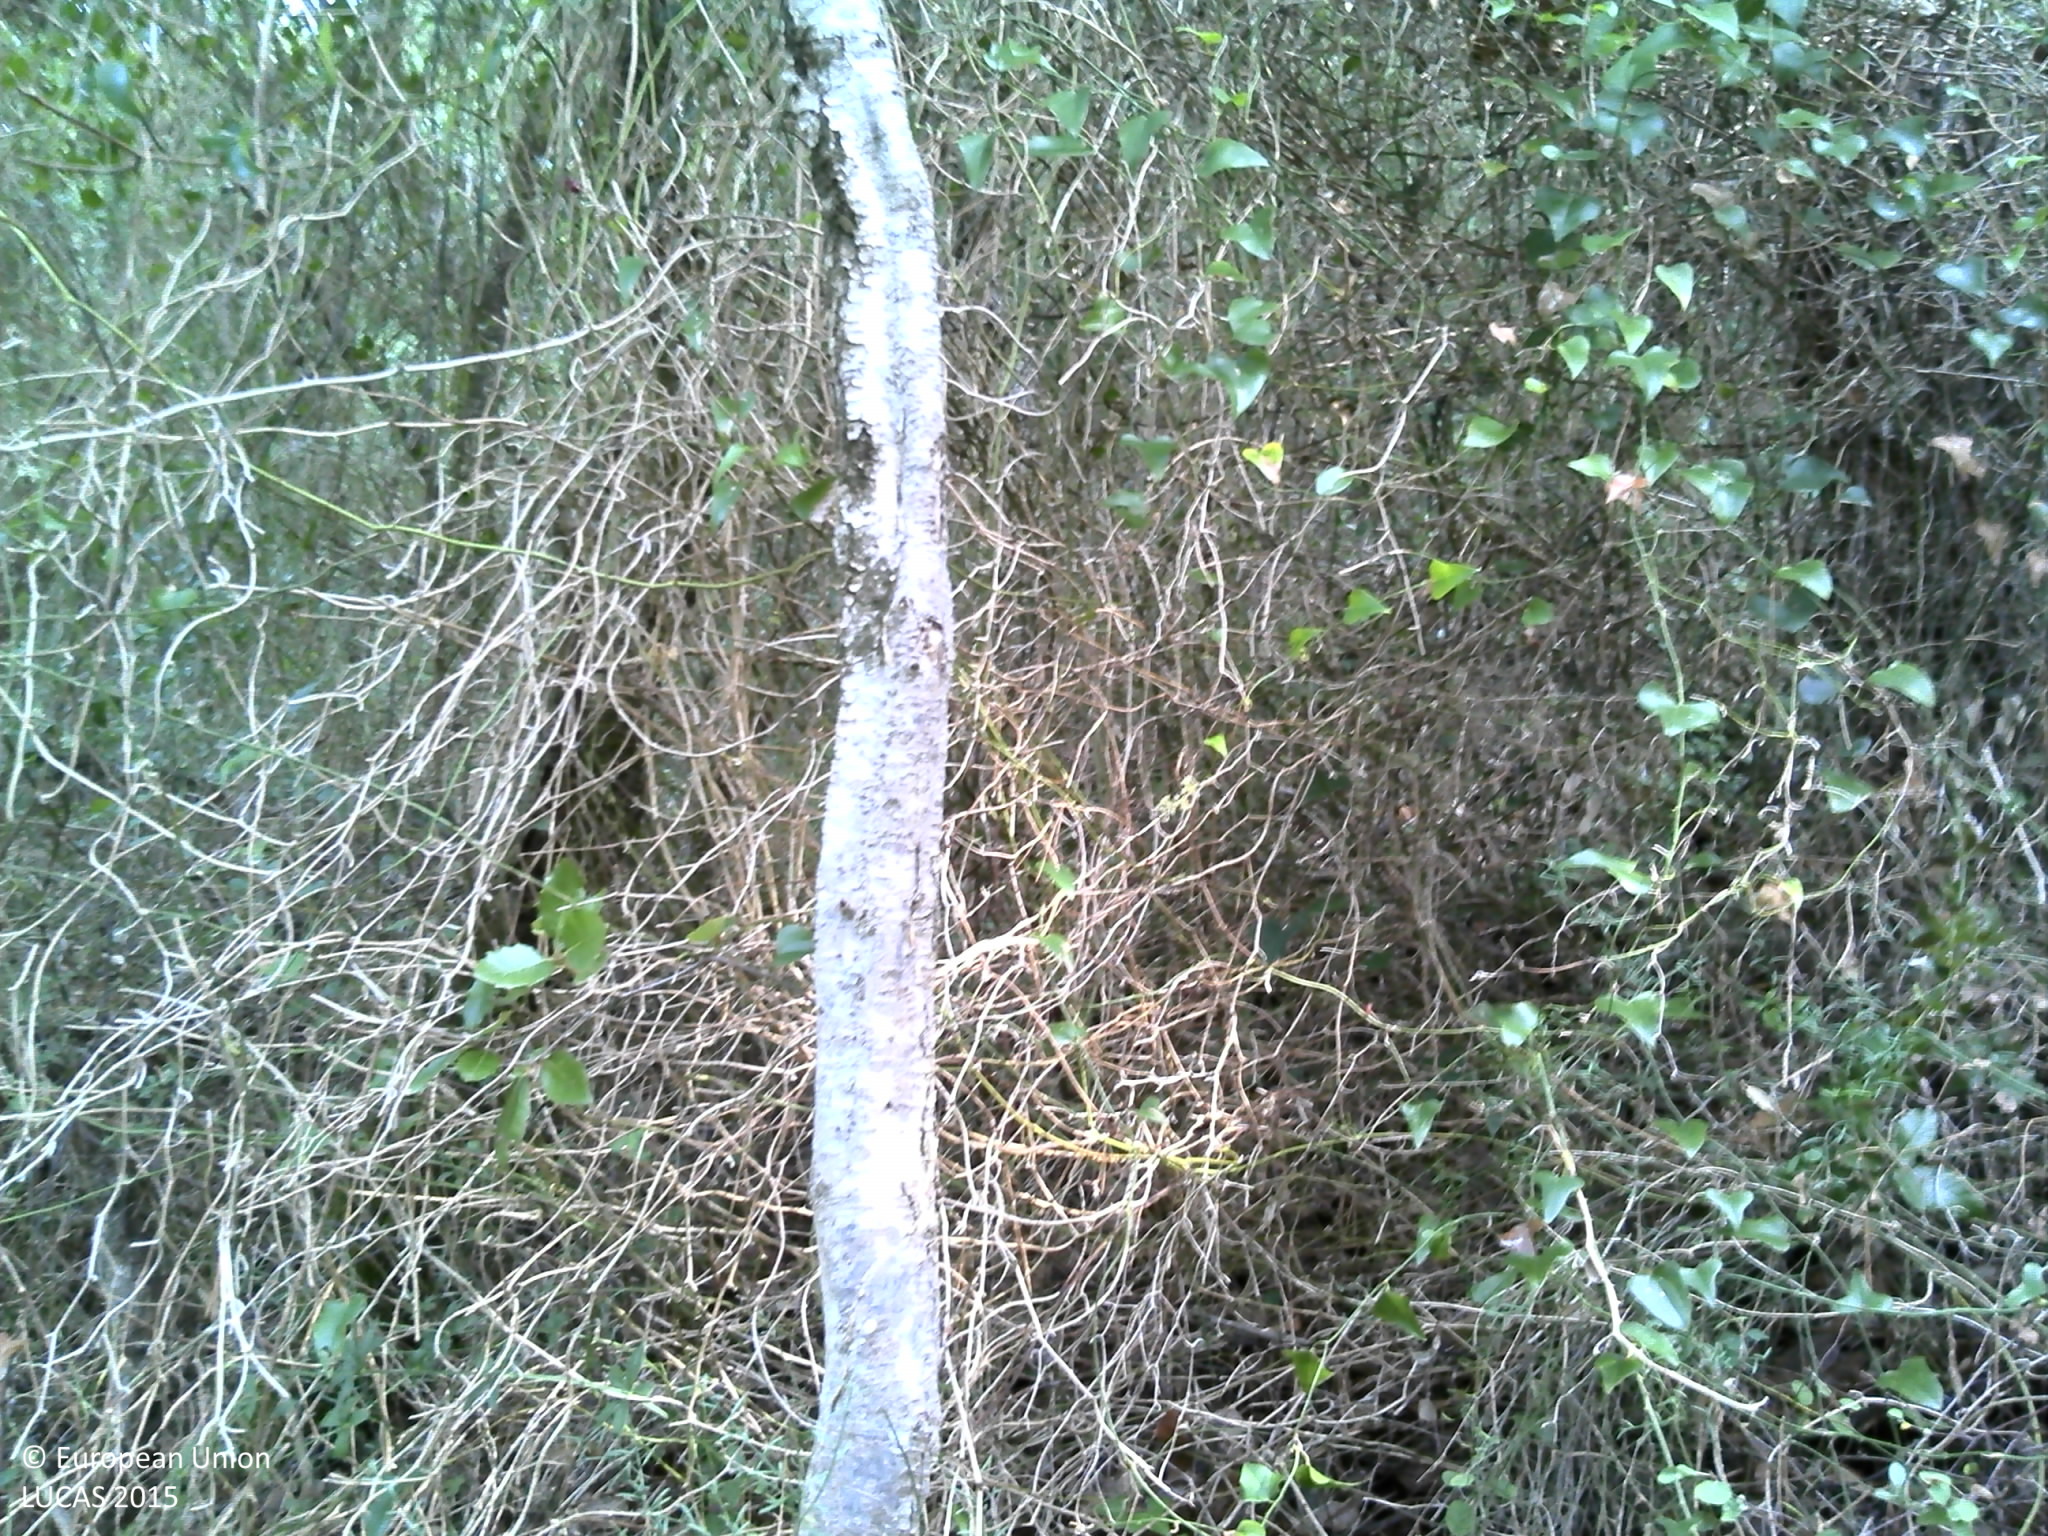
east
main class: Woodland
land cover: Pine dominated mixed woodland
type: broadleaved evergreen forest
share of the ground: > 75 %
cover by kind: broadleaved forest trees 50 %, coniferous forest trees 25 %, herbaceous plants 15 %, lichens and mosses 5 %, unconsolidated bare surface 5 %
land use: Forestry
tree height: > 5 m
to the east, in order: Pine dominated mixed woodland; Electric lines; Tracks; Pine dominated mixed woodland; Shrubland with sparse tree cover
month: September
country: FR
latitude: 43.5891
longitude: 6.5526
